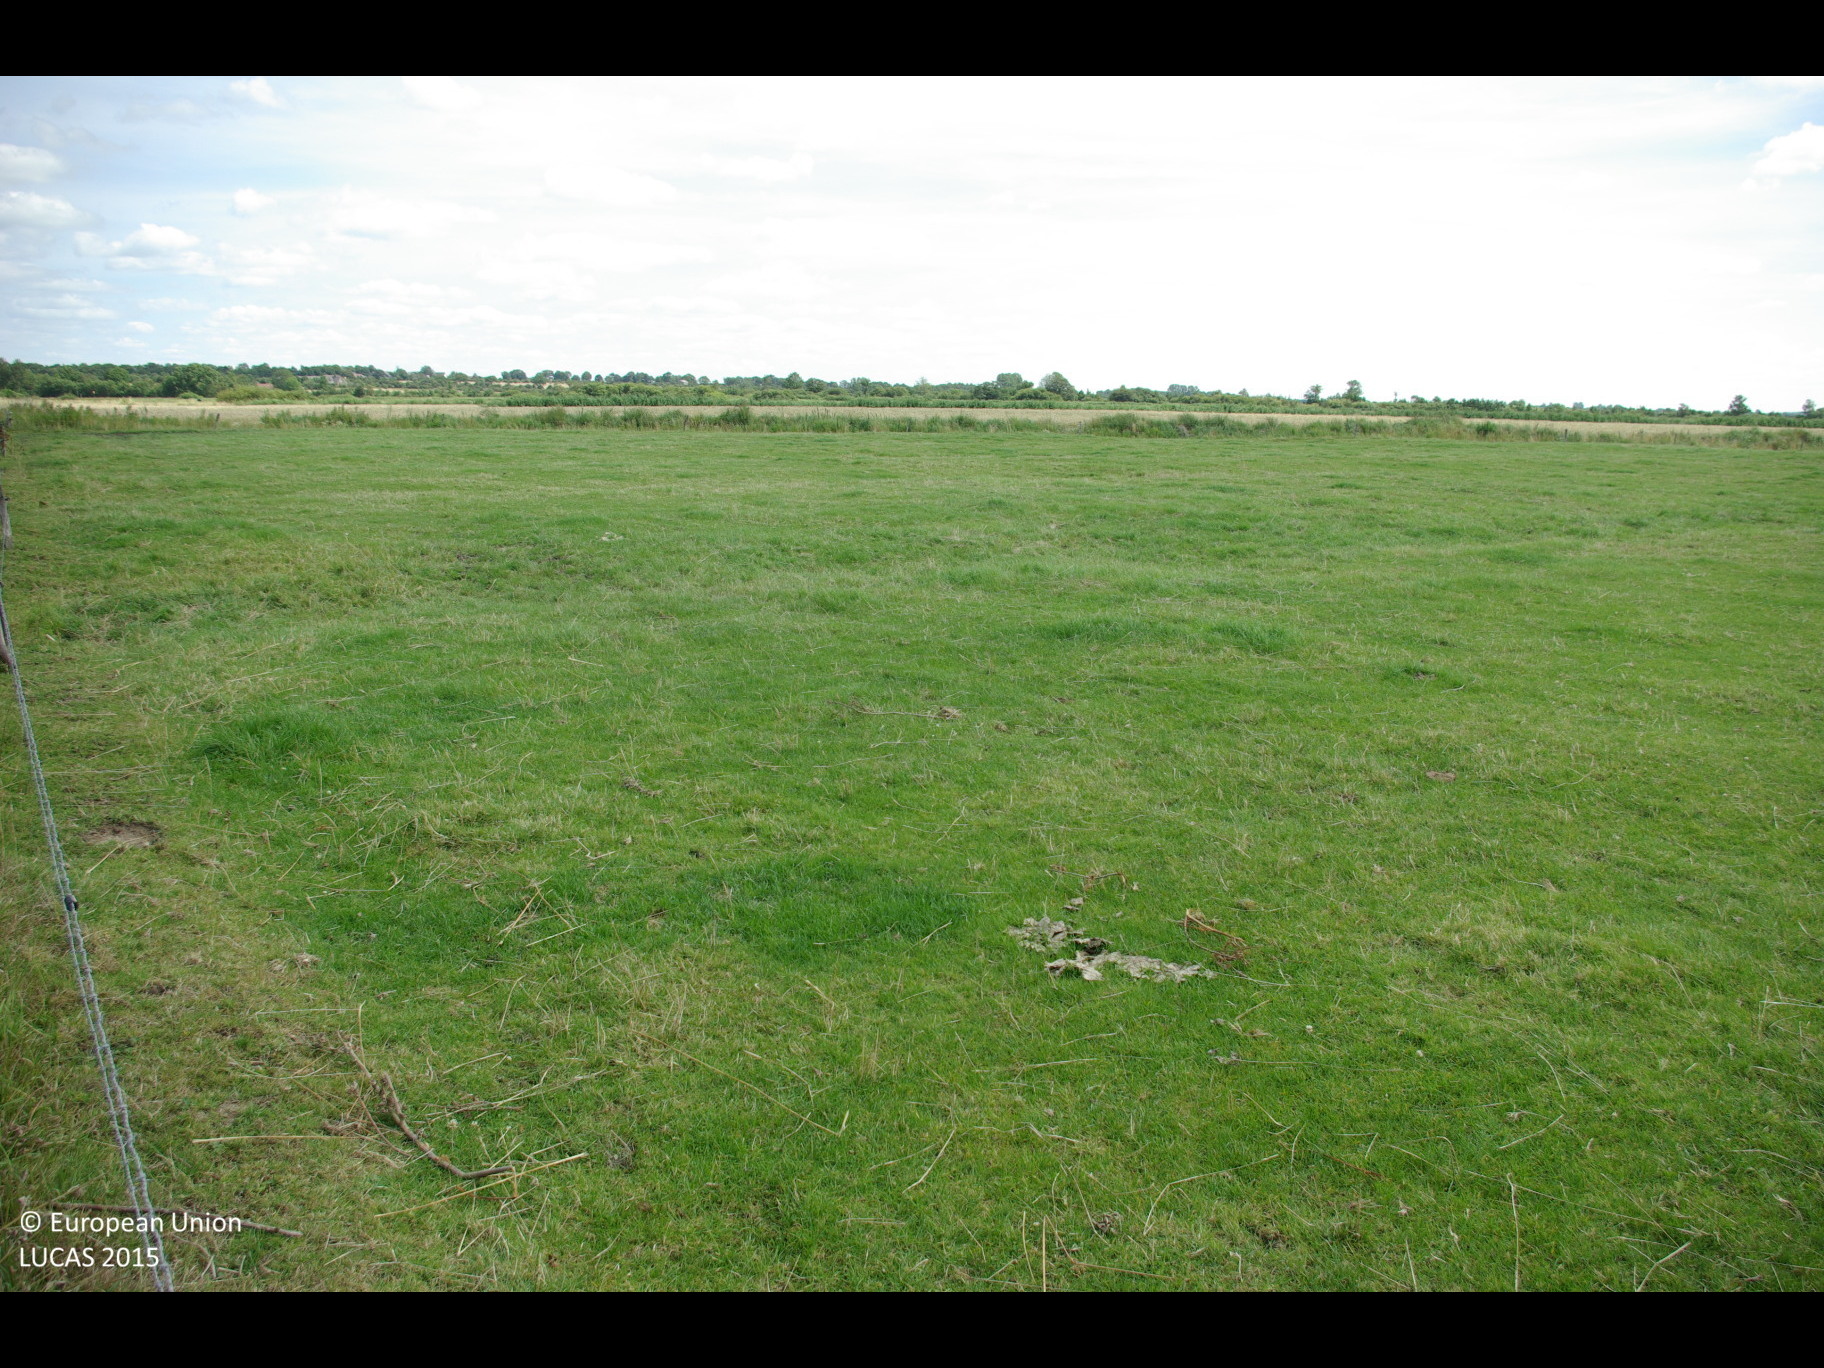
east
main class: Grassland
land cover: Grassland without tree/shrub cover
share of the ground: > 75 %
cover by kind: herbaceous plants 100 %
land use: Agriculture (excluding fallow land and kitchen gardens)
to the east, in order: Grassland without tree/shrub cover; Fences; Shruby margins; Ditches and canals; Spontaneously vegetated surfaces; Common wheat; Ditches and canals; Ponds and wetlands; Common wheat; Spontaneously vegetated surfaces; Inland marshes; Ditches and canals; Ponds and wetlands; Fences; Grassland without tree/shrub cover
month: August
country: DE
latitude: 54.4587
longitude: 9.0596
